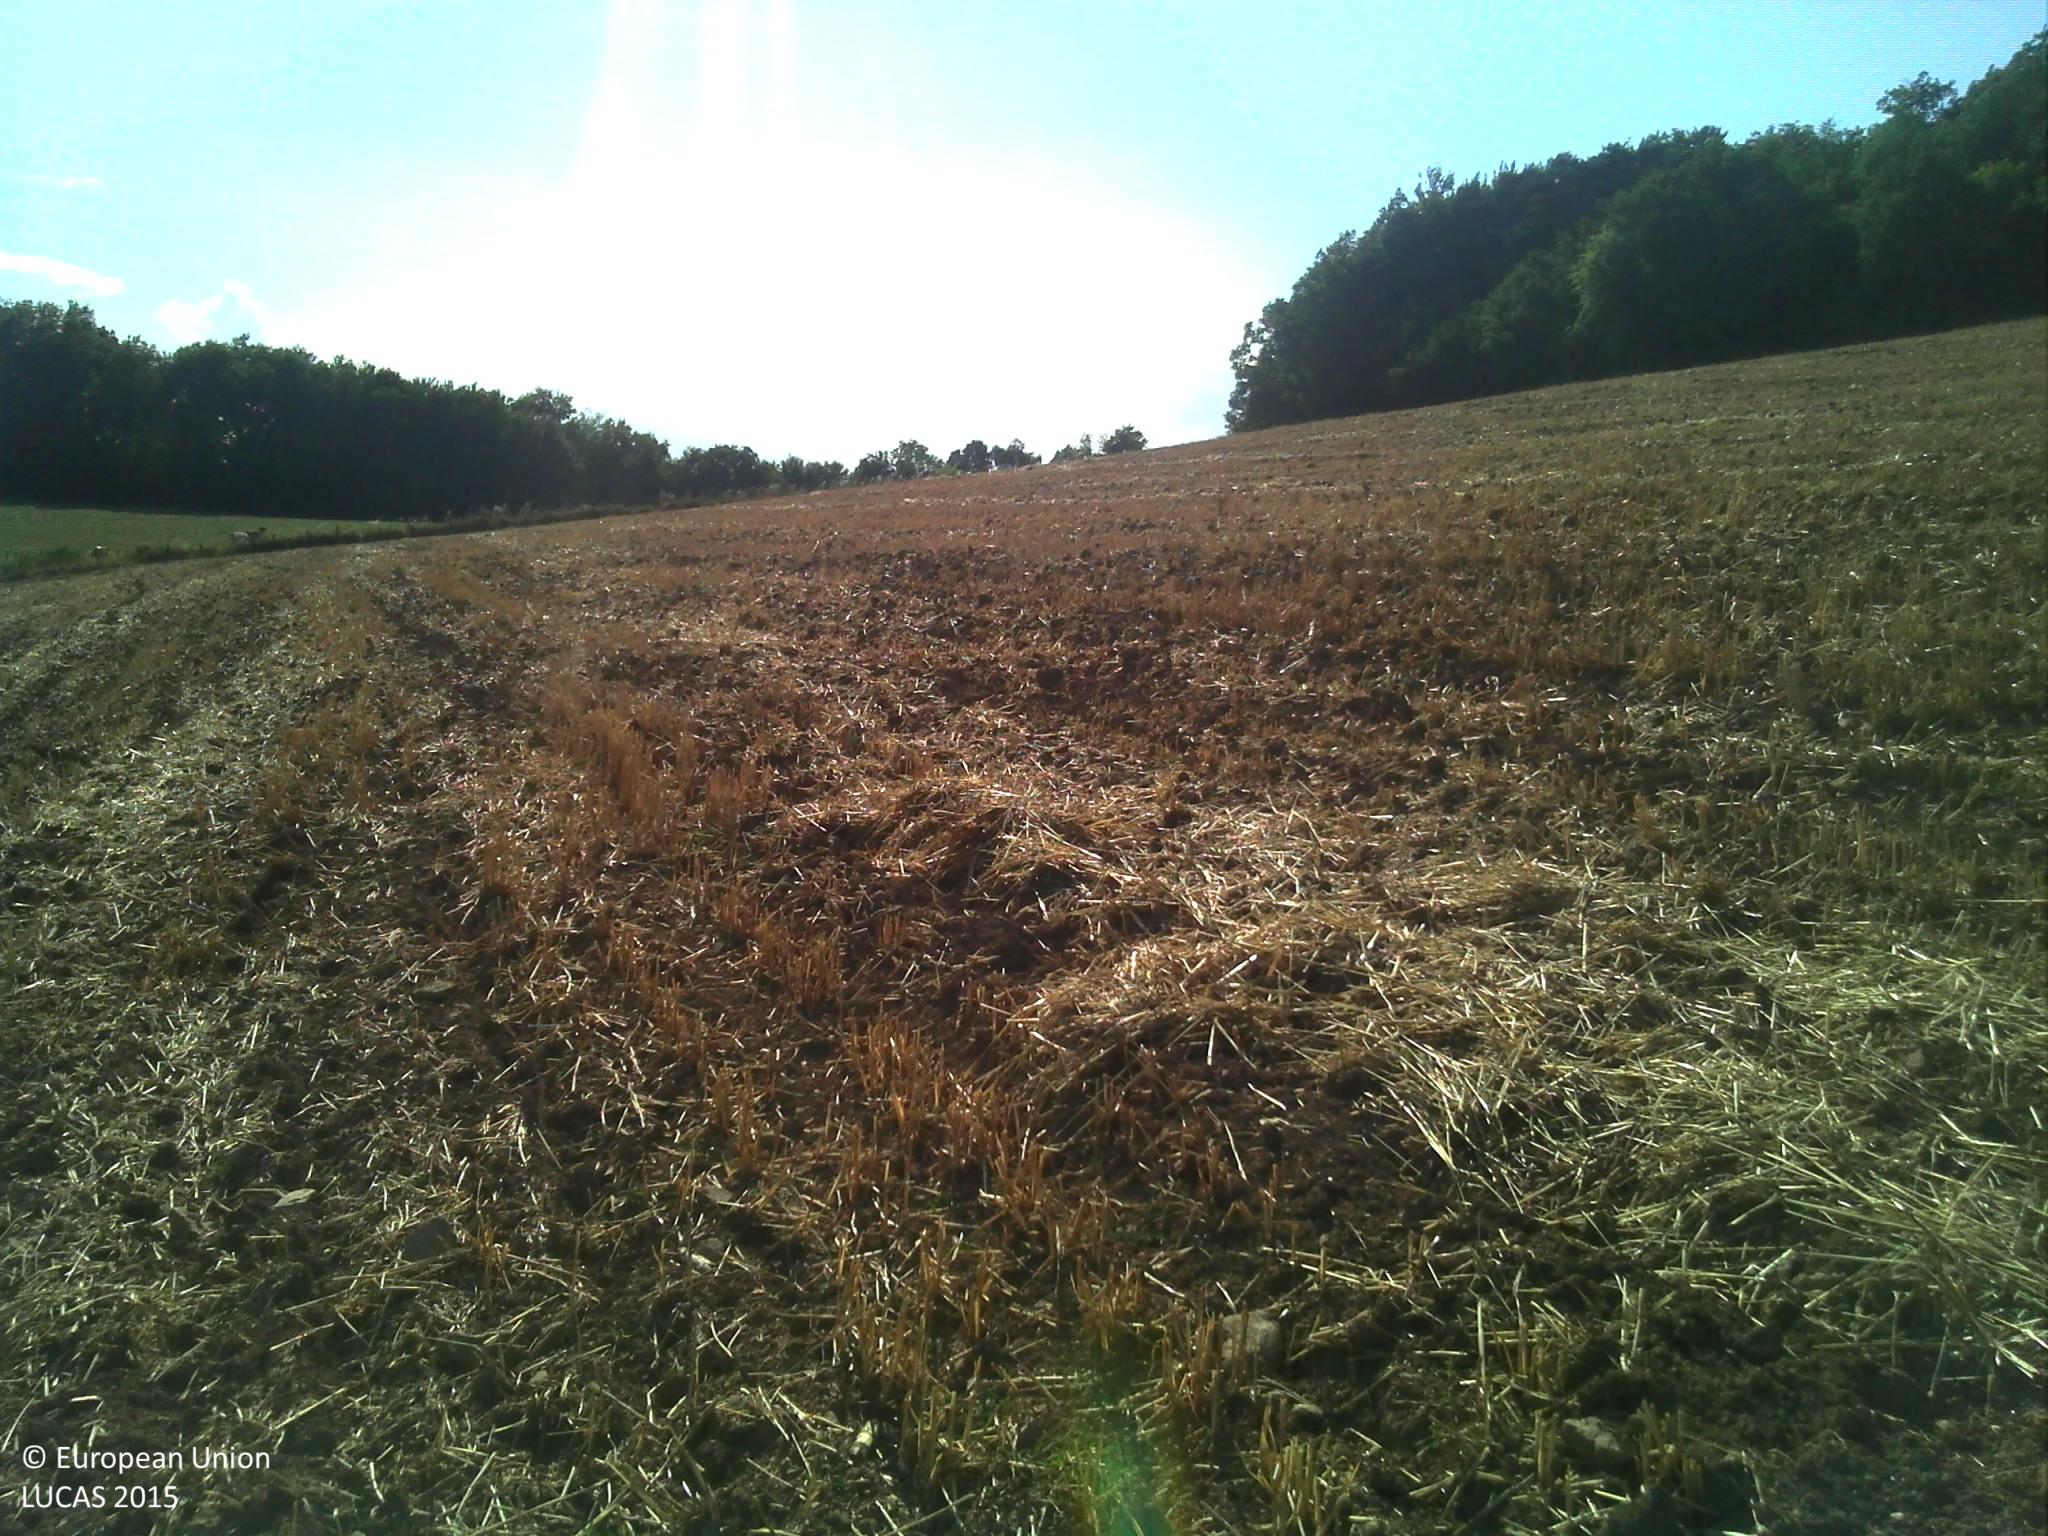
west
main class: Cropland
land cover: Durum wheat
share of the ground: 10 - 25 %
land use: Agriculture (excluding fallow land and kitchen gardens)
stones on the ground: 10 - 25 %
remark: Harvested field
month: August
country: FR
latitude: 45.6180
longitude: 4.5788
